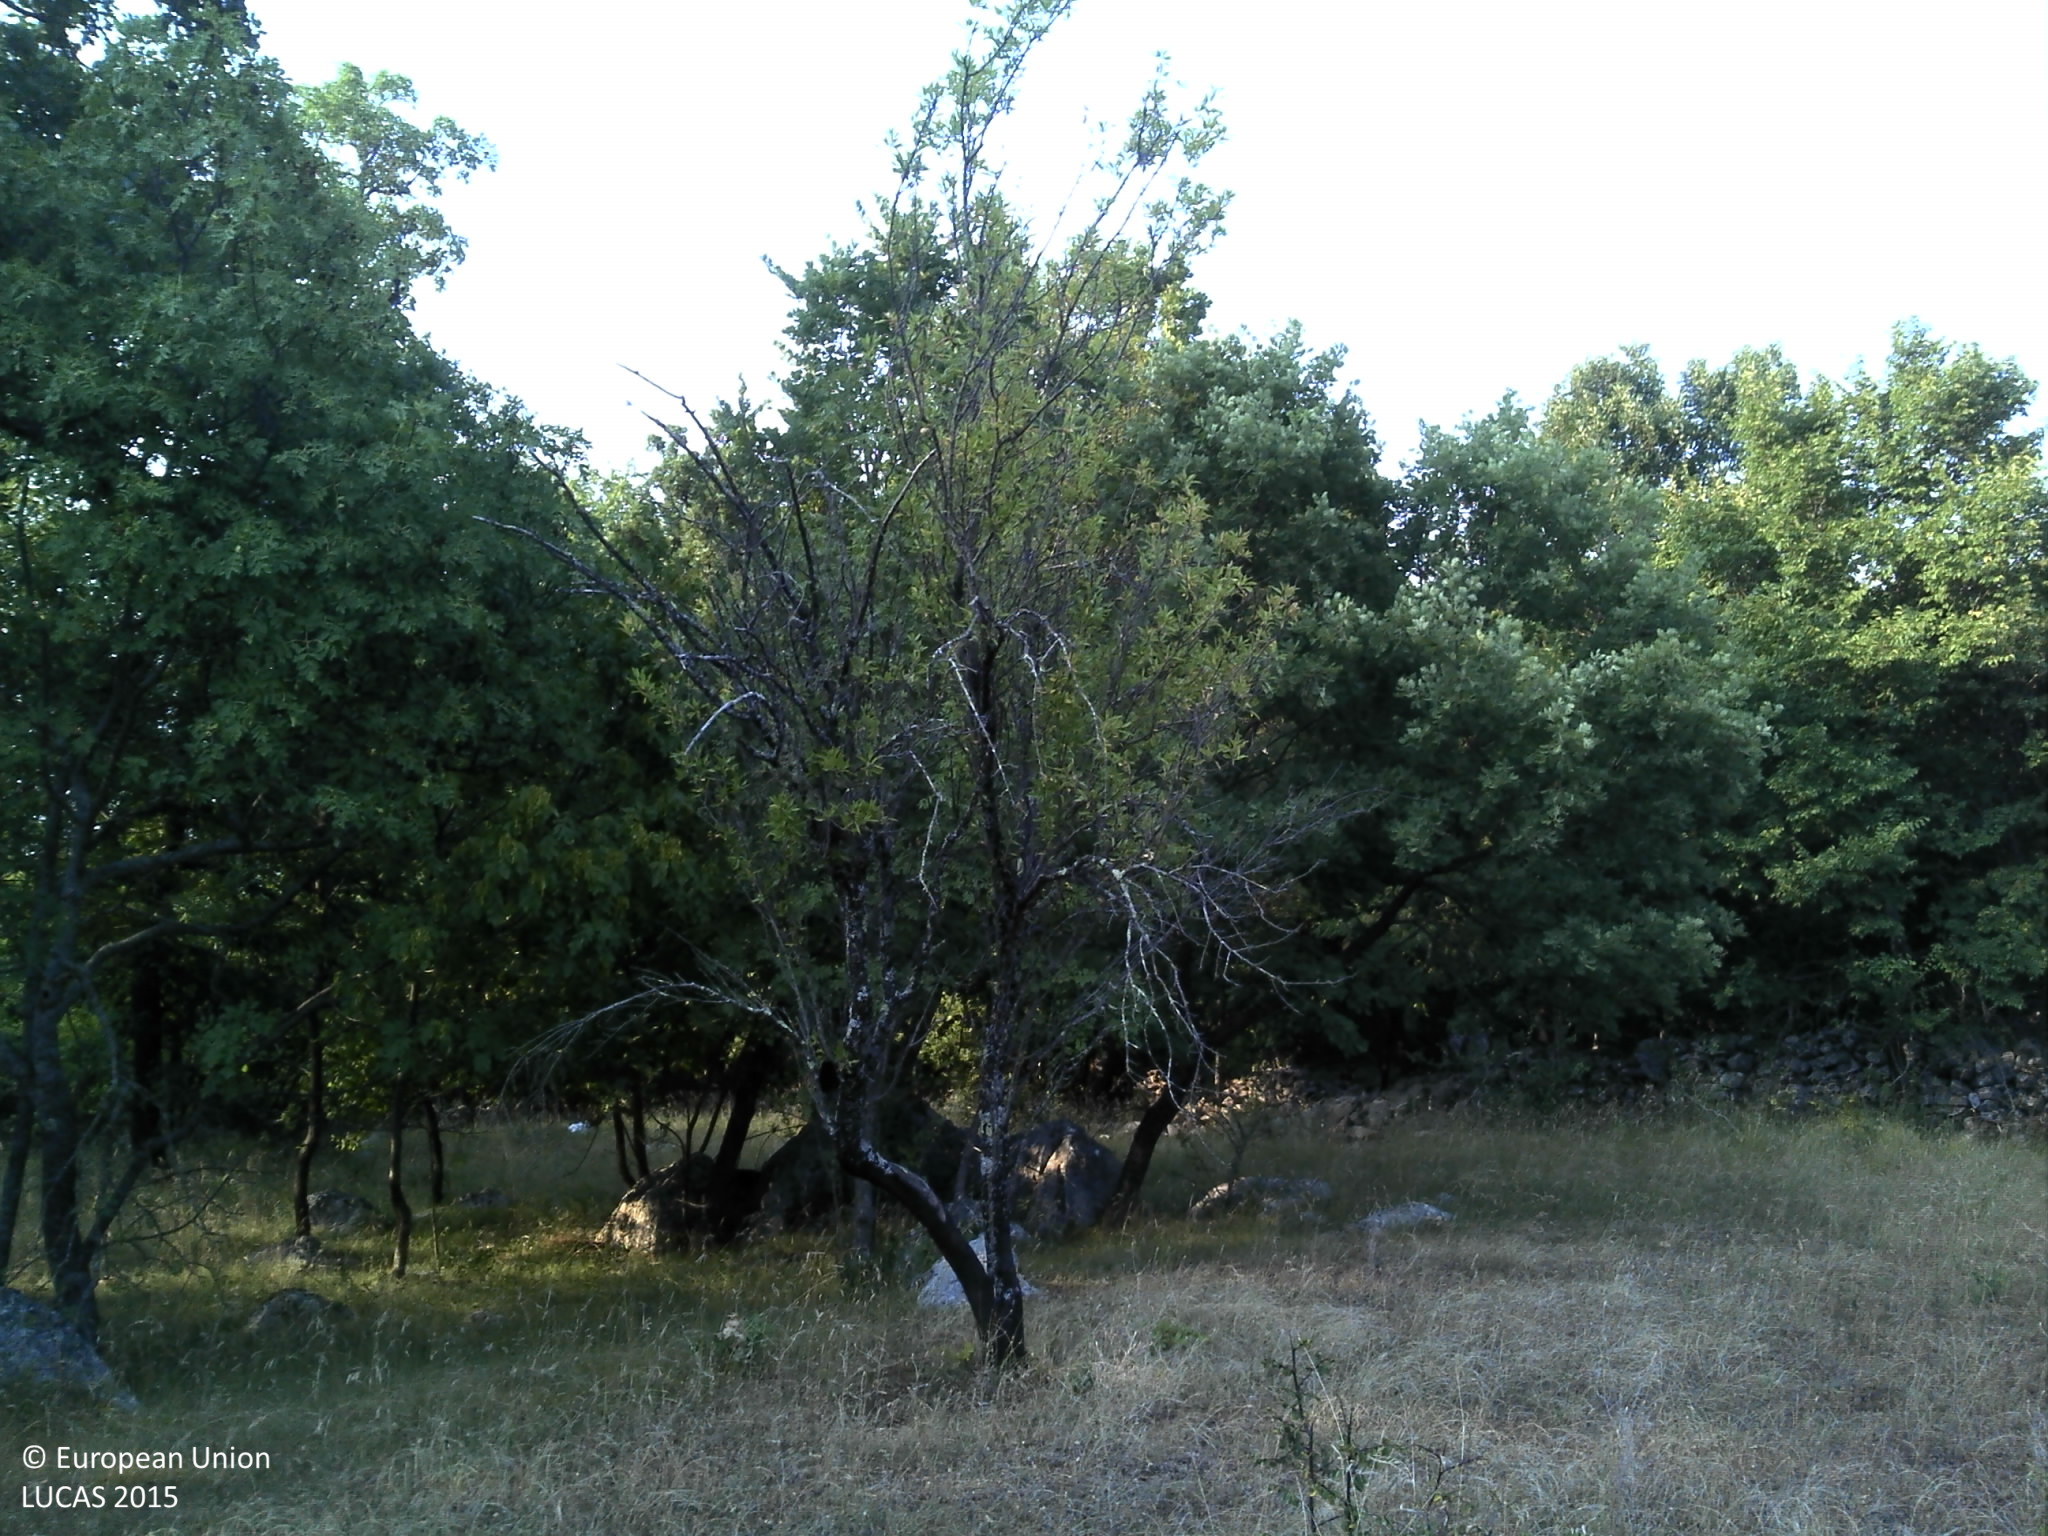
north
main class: Grassland
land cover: Grassland without tree/shrub cover
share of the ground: > 75 %
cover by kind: herbaceous plants 95 %, shrubs 5 %
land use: Semi-natural and natural areas not in use
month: July
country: HR
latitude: 43.9445
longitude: 16.2593
